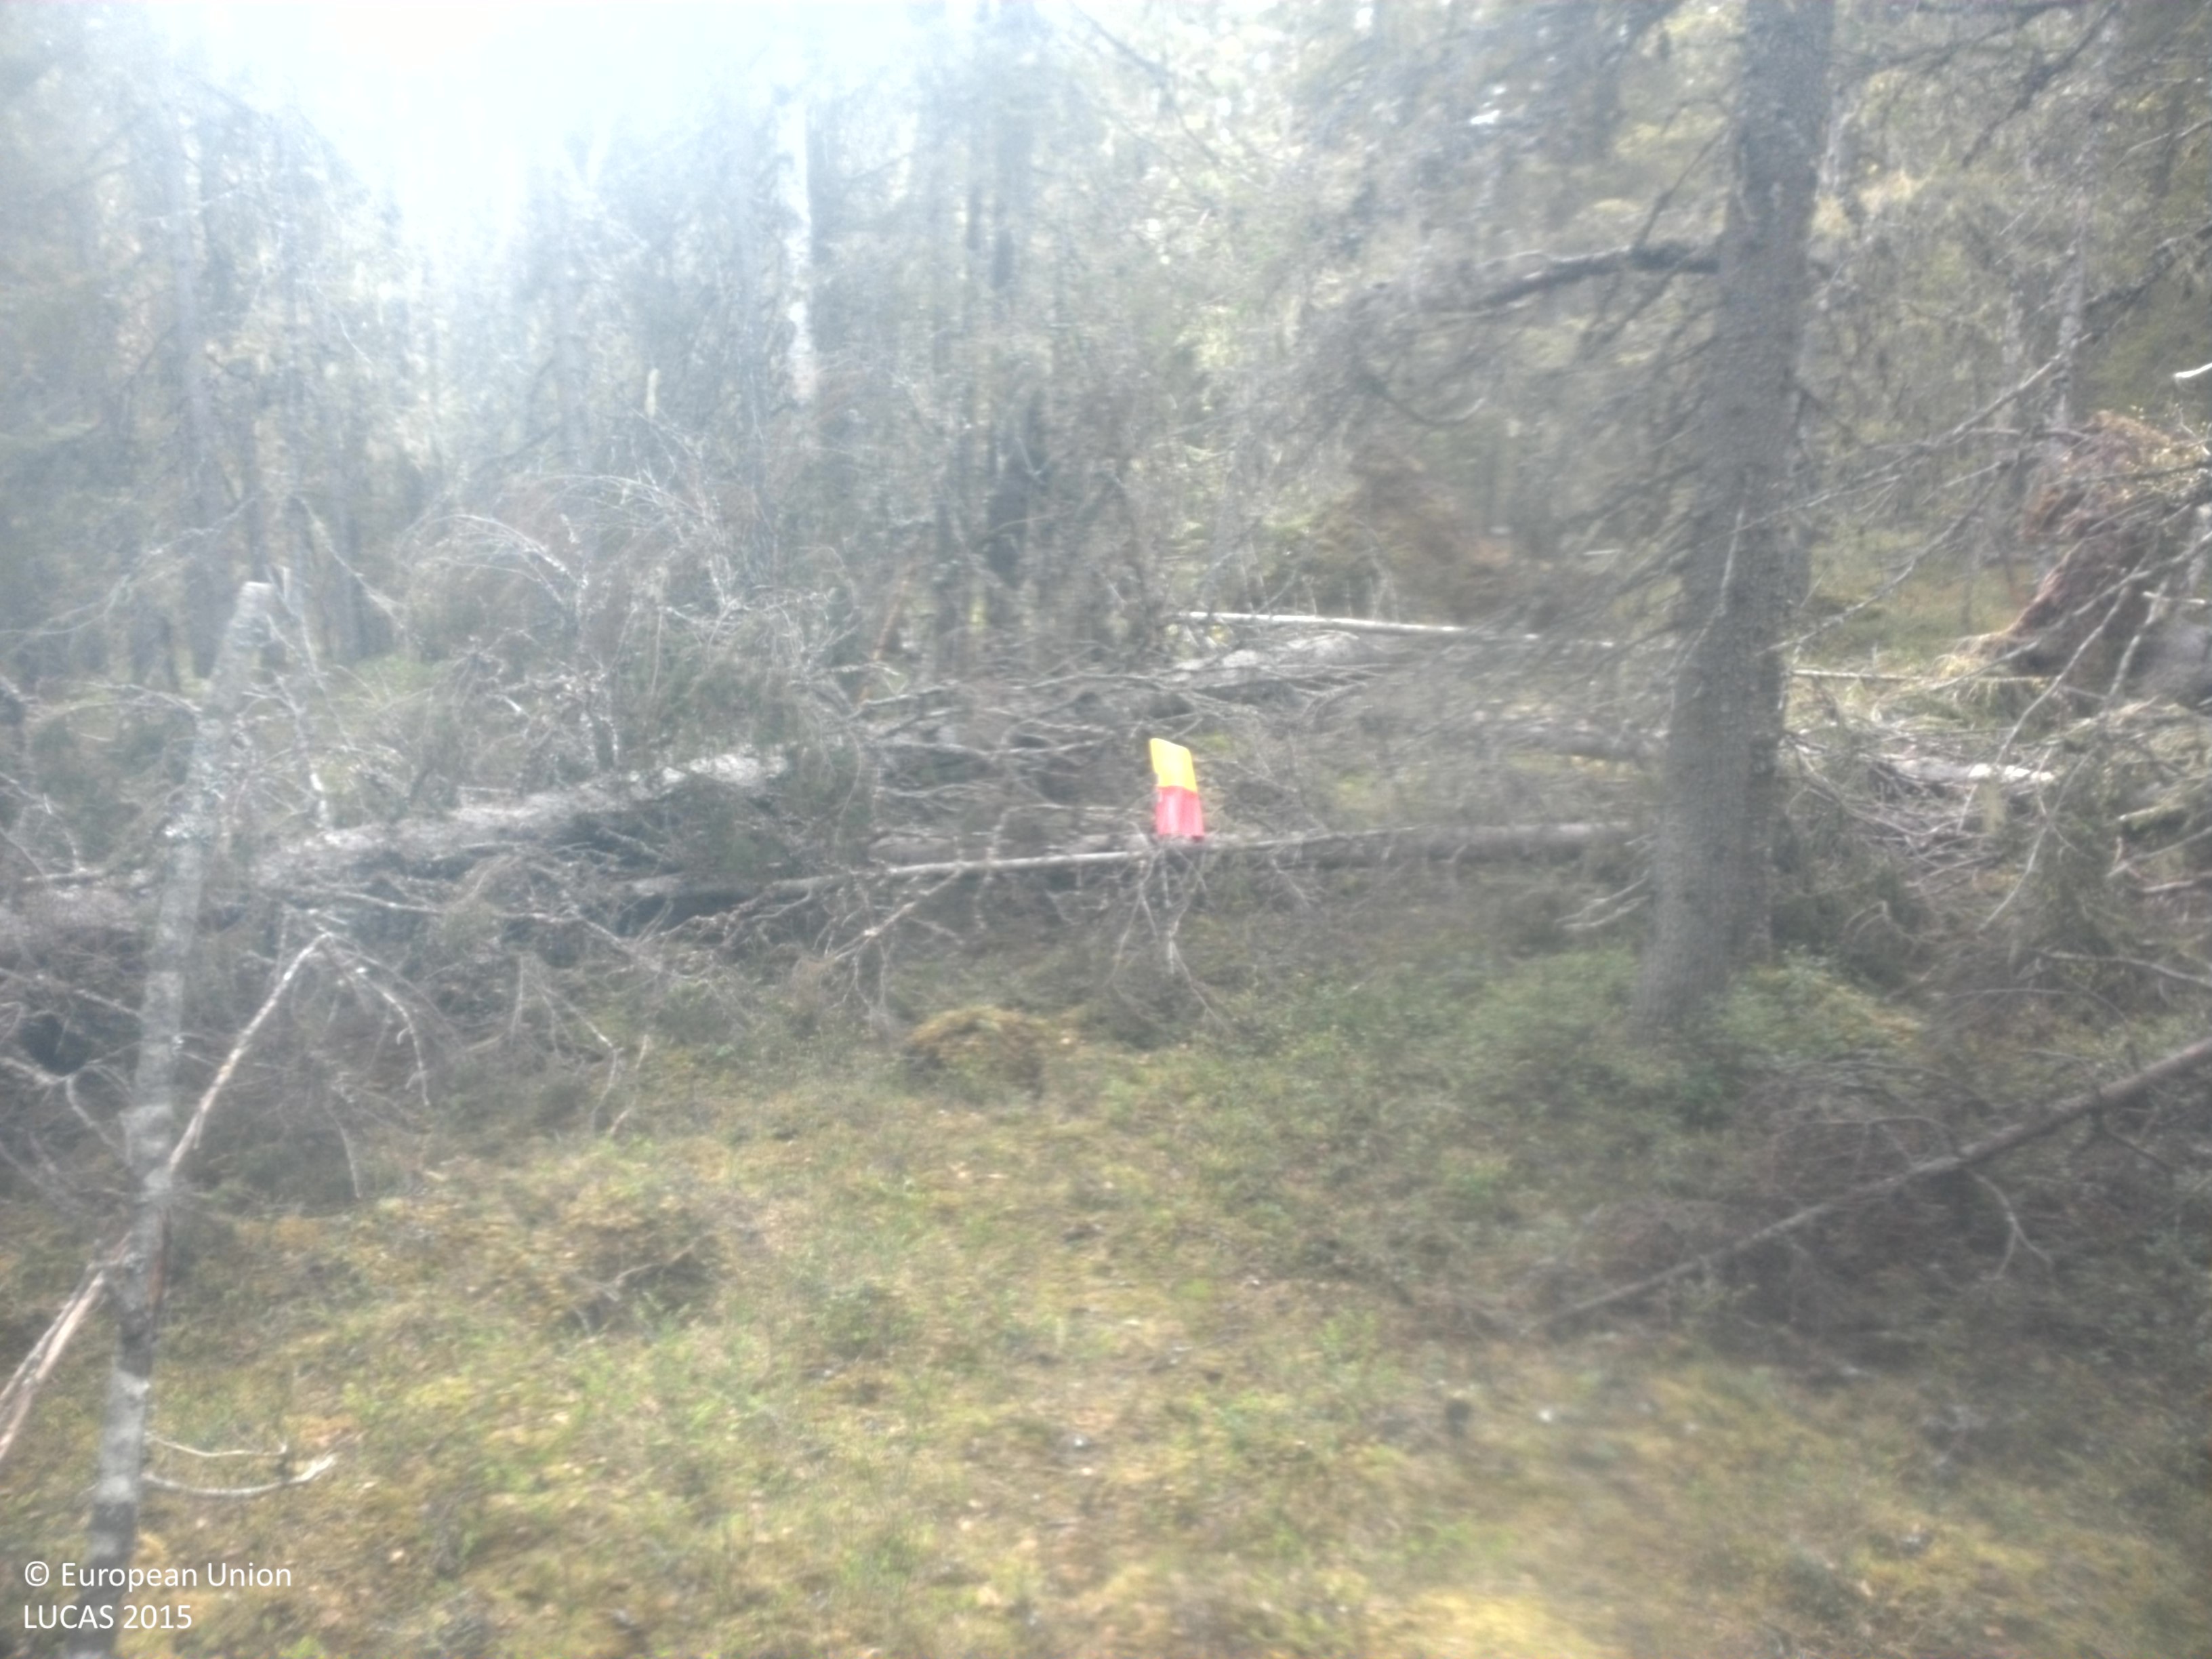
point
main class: Woodland
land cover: Spruce dominated coniferous woodland
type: boreal forest
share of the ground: 25 - 50 %
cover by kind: coniferous forest trees 45 %, herbaceous plants 25 %, lichens and mosses 10 %, unconsolidated bare surface 10 %, broadleaved forest trees 5 %, shrubs 5 %
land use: Forestry
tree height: > 5 m
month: June
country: SE
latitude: 64.4463
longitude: 17.7178
